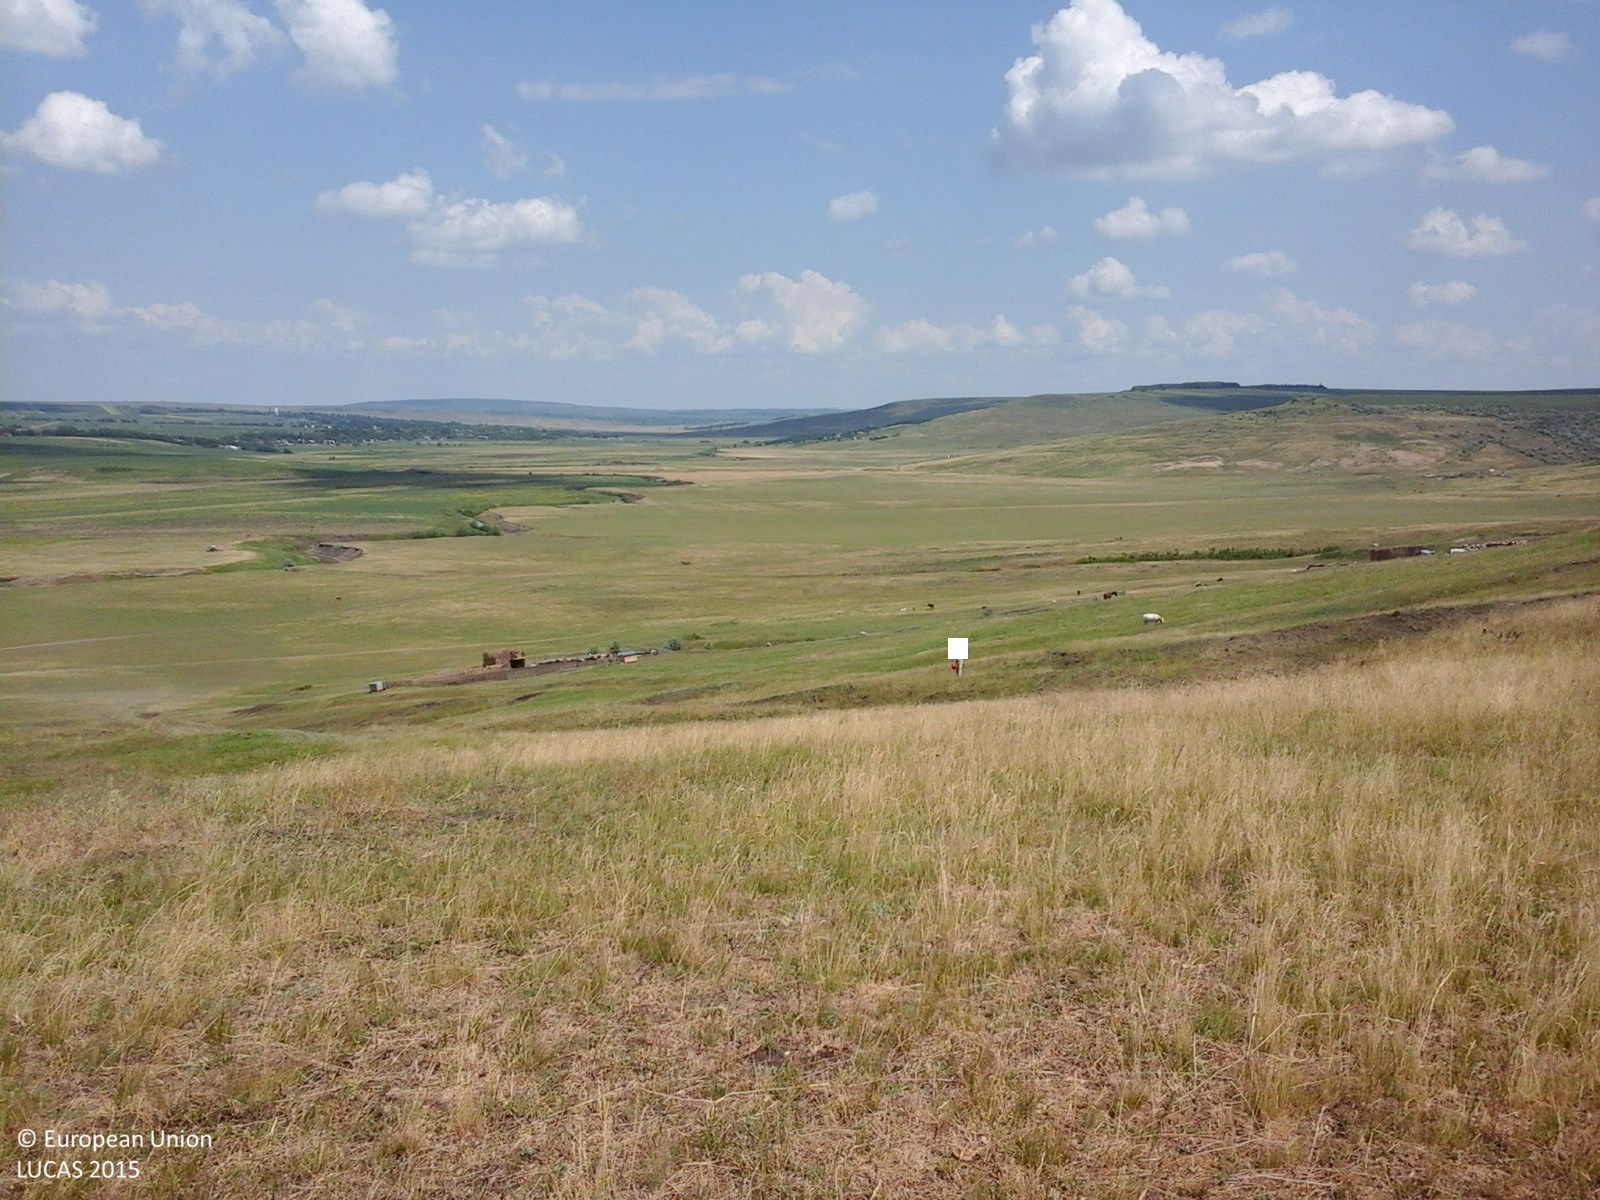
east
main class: Grassland
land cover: Grassland without tree/shrub cover
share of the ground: > 75 %
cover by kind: herbaceous plants 100 %
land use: Agriculture (excluding fallow land and kitchen gardens)
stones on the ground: < 10 %
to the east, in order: Grassland without tree/shrub cover
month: June
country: RO
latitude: 47.6014
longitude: 27.0368
